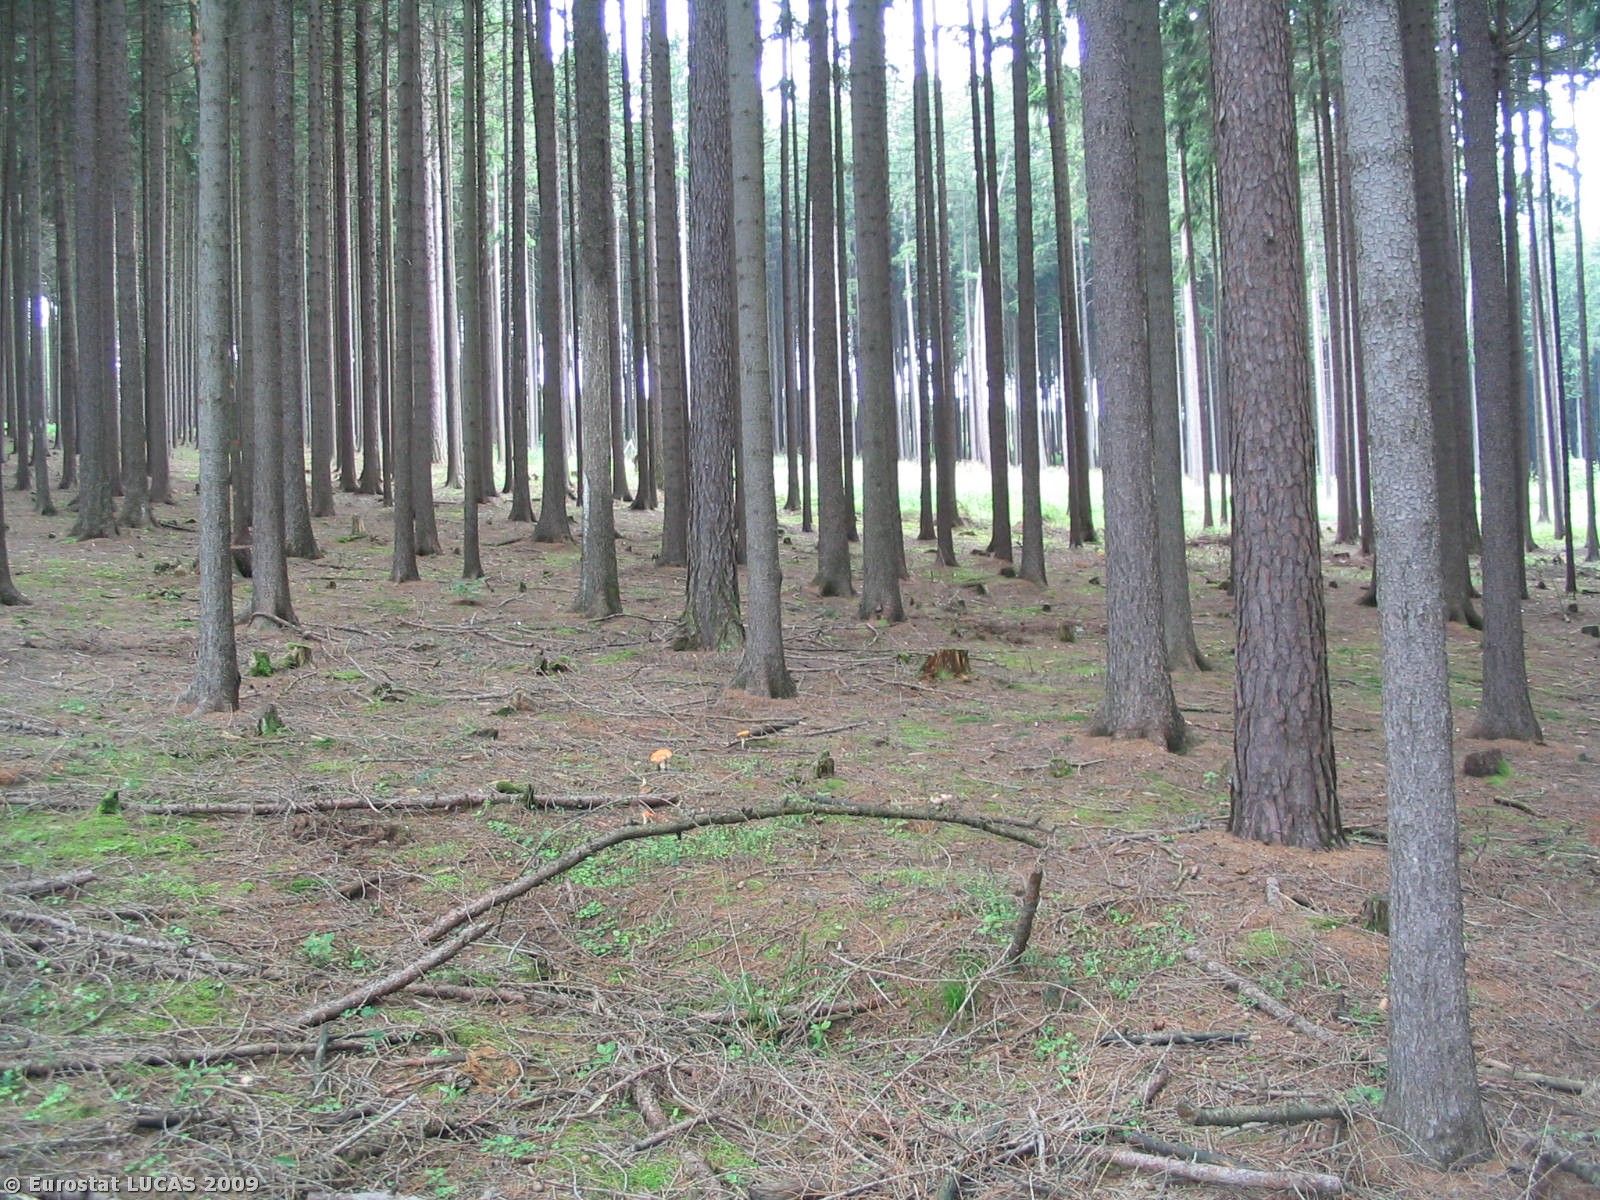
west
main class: Woodland
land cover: Coniferous woodland
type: hemiboreal forest and nemoral coniferous forest and mixed broadleaved-coniferous forest
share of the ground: > 75 %
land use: Forestry
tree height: > 5 m
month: July
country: CZ
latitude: 49.4051
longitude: 16.4704
